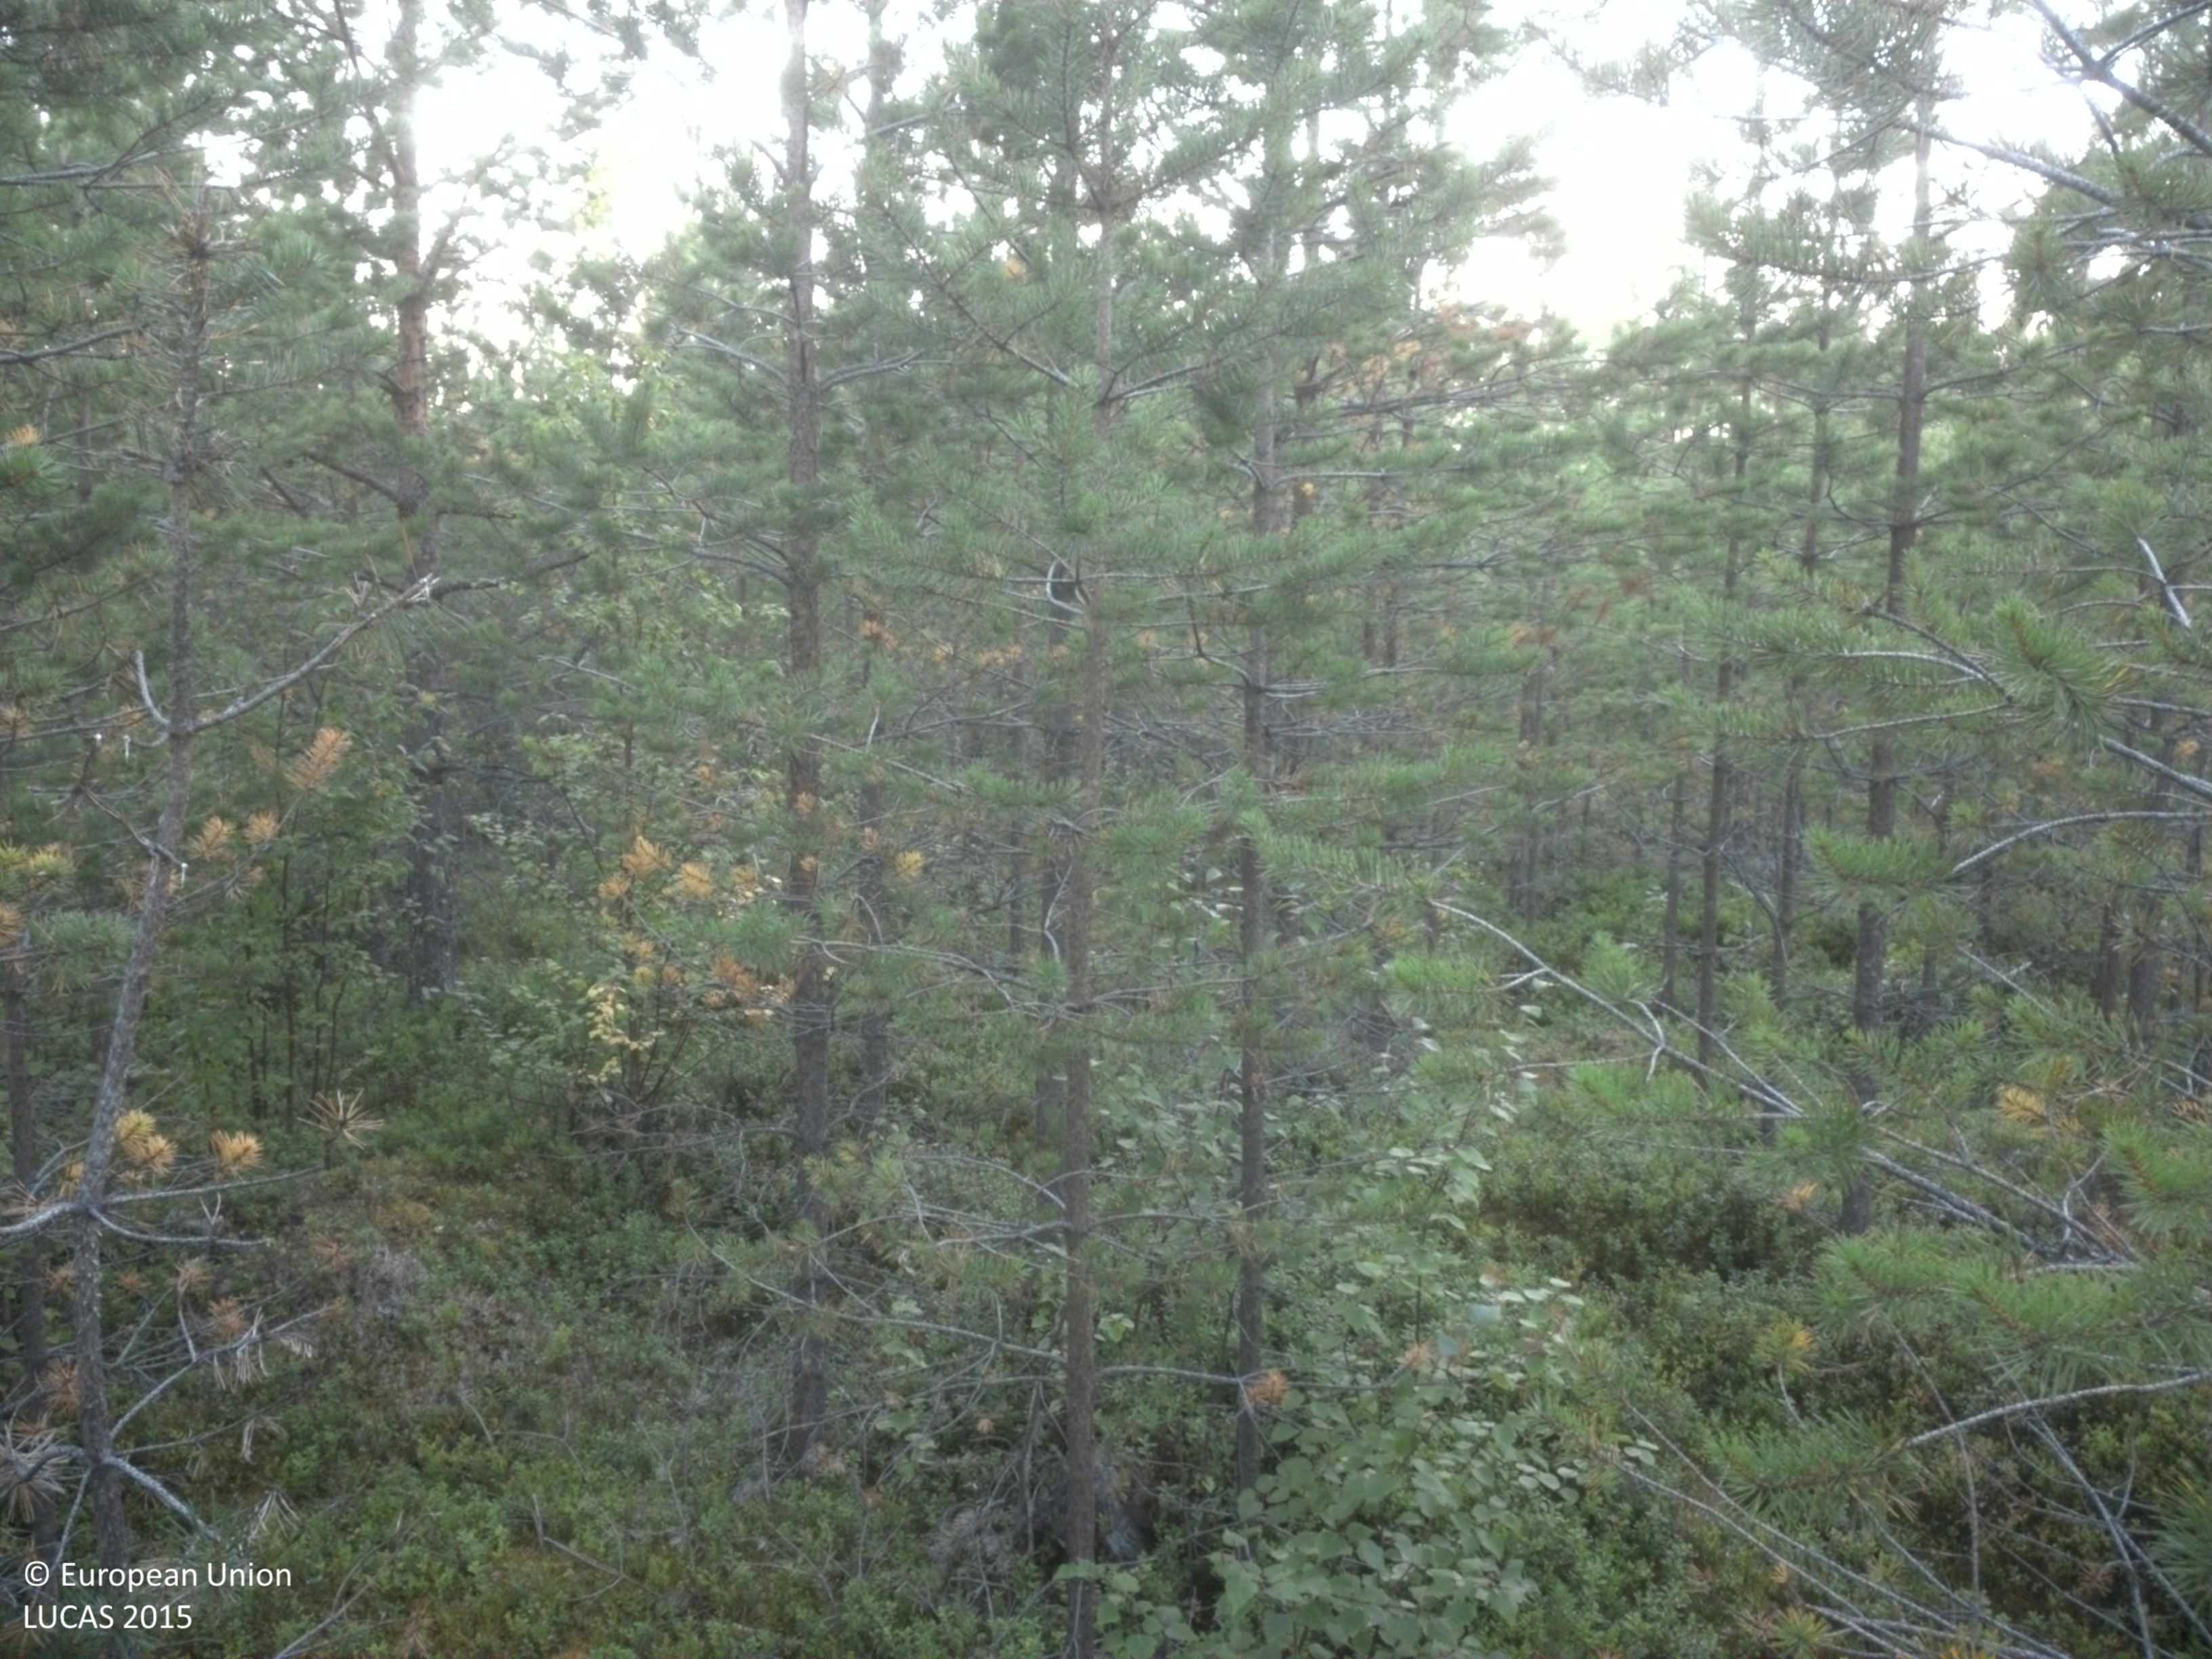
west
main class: Woodland
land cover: Pine dominated coniferous woodland
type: boreal forest
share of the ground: 50 - 75 %
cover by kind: coniferous forest trees 70 %, shrubs 30 %
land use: Forestry
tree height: < 5 m
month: August
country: SE
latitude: 64.6391
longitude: 18.9032
